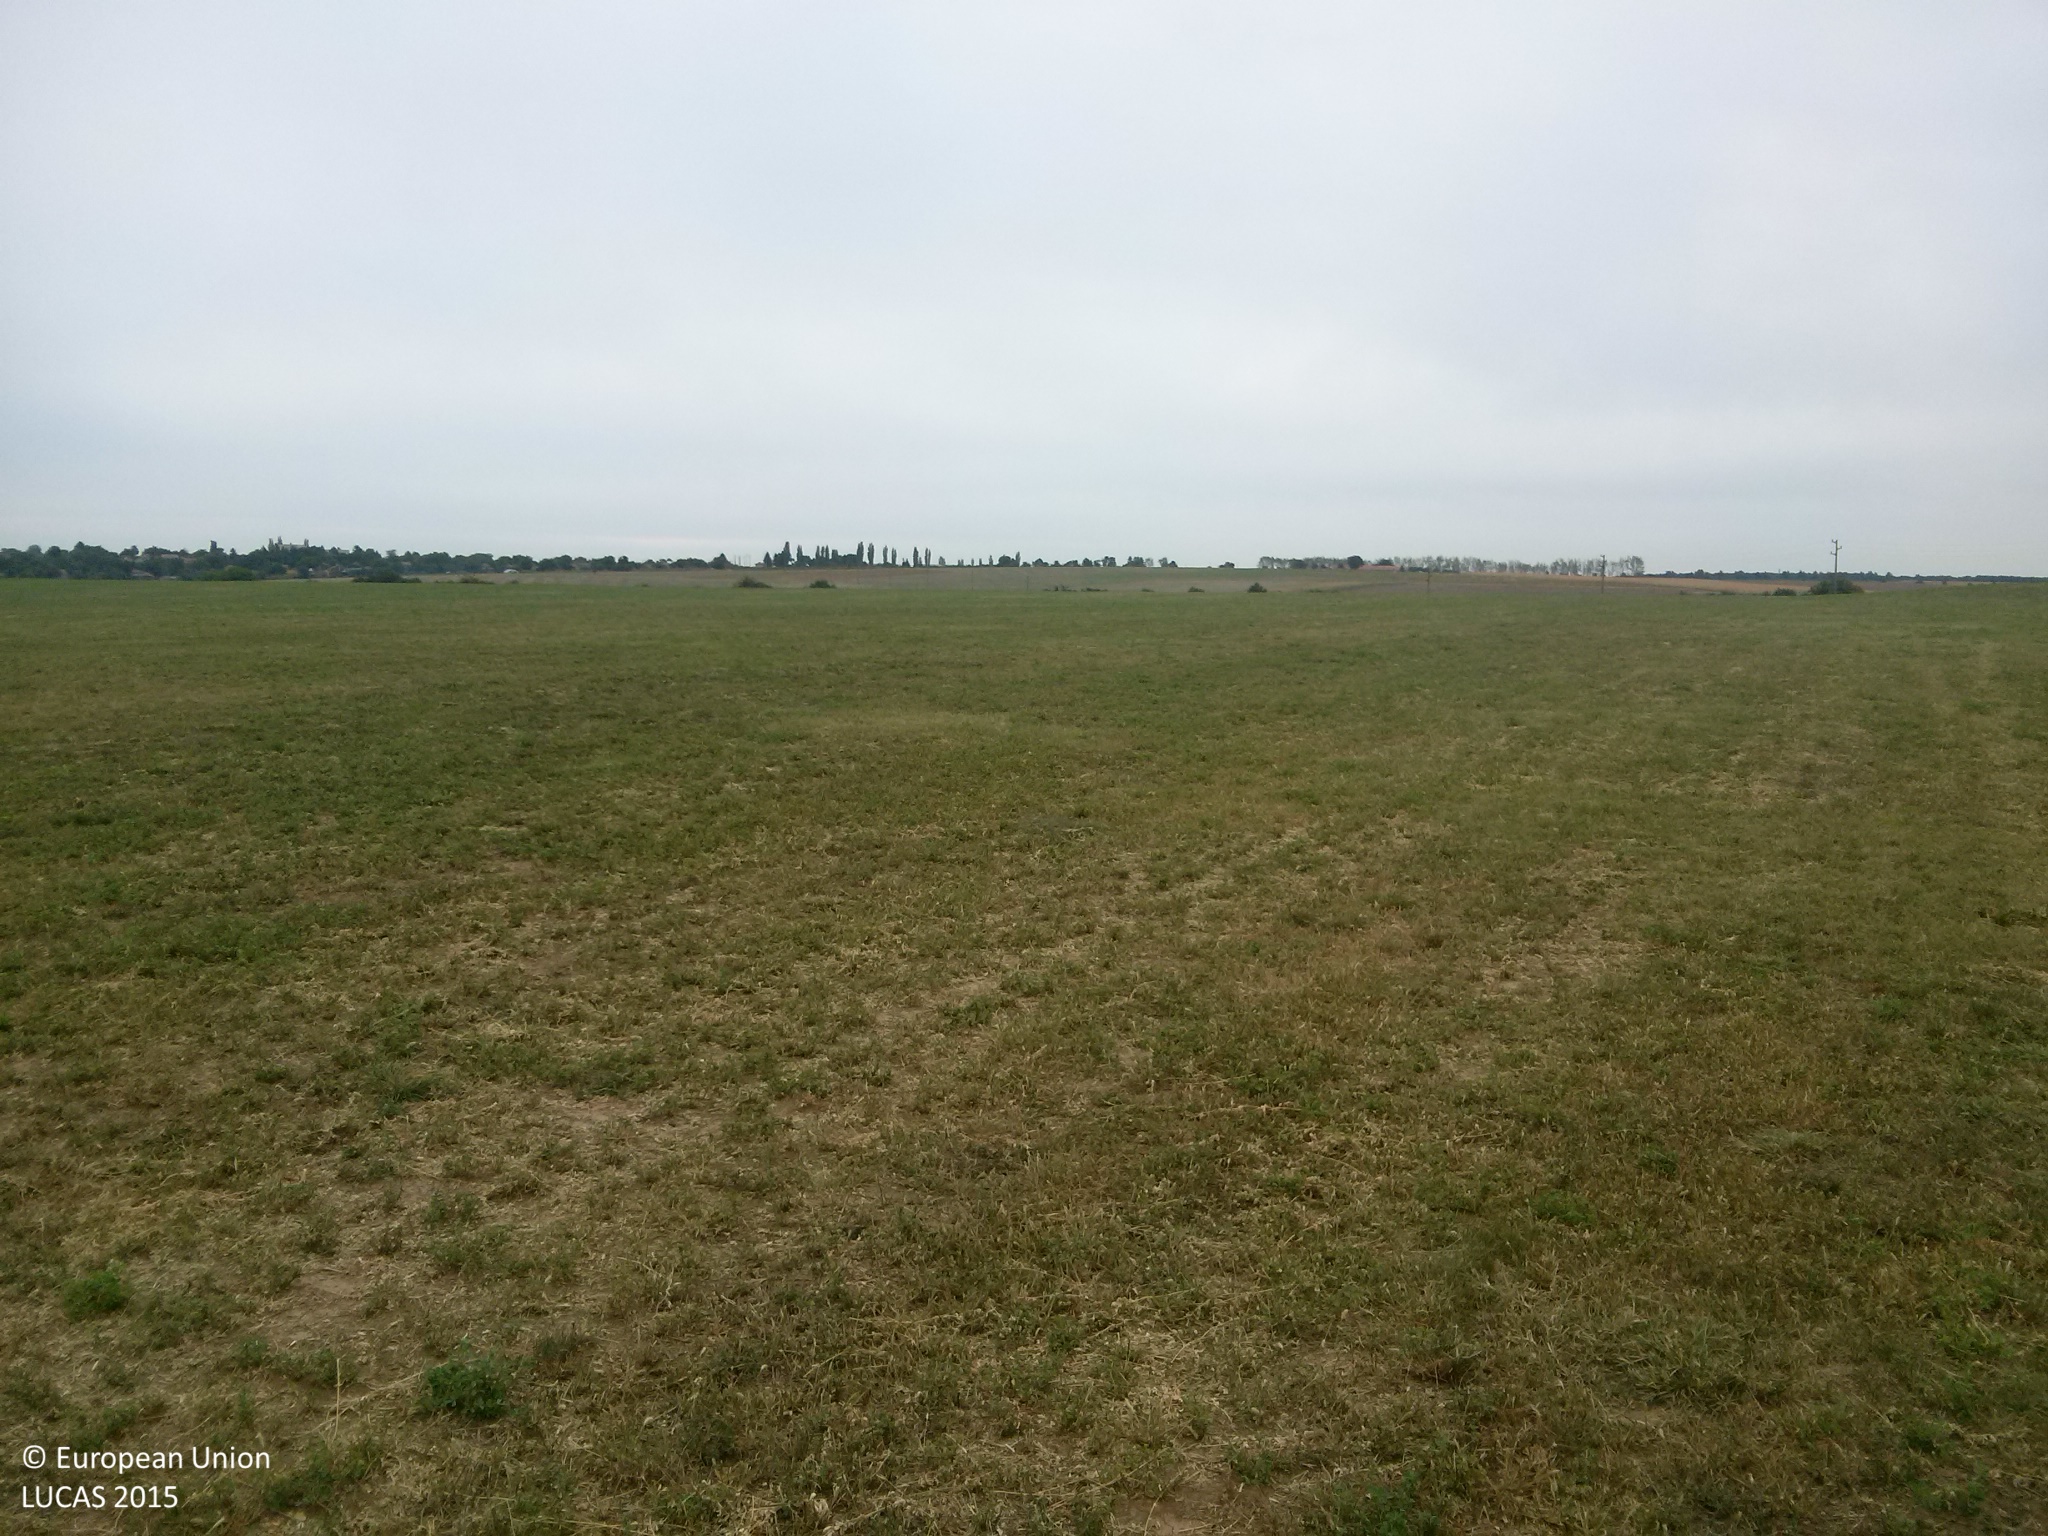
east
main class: Cropland
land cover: Lucerne
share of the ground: 50 - 75 %
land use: Agriculture (excluding fallow land and kitchen gardens)
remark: Harvested field
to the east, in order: Lucerne
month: September
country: BG
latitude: 43.7469
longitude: 26.7670
